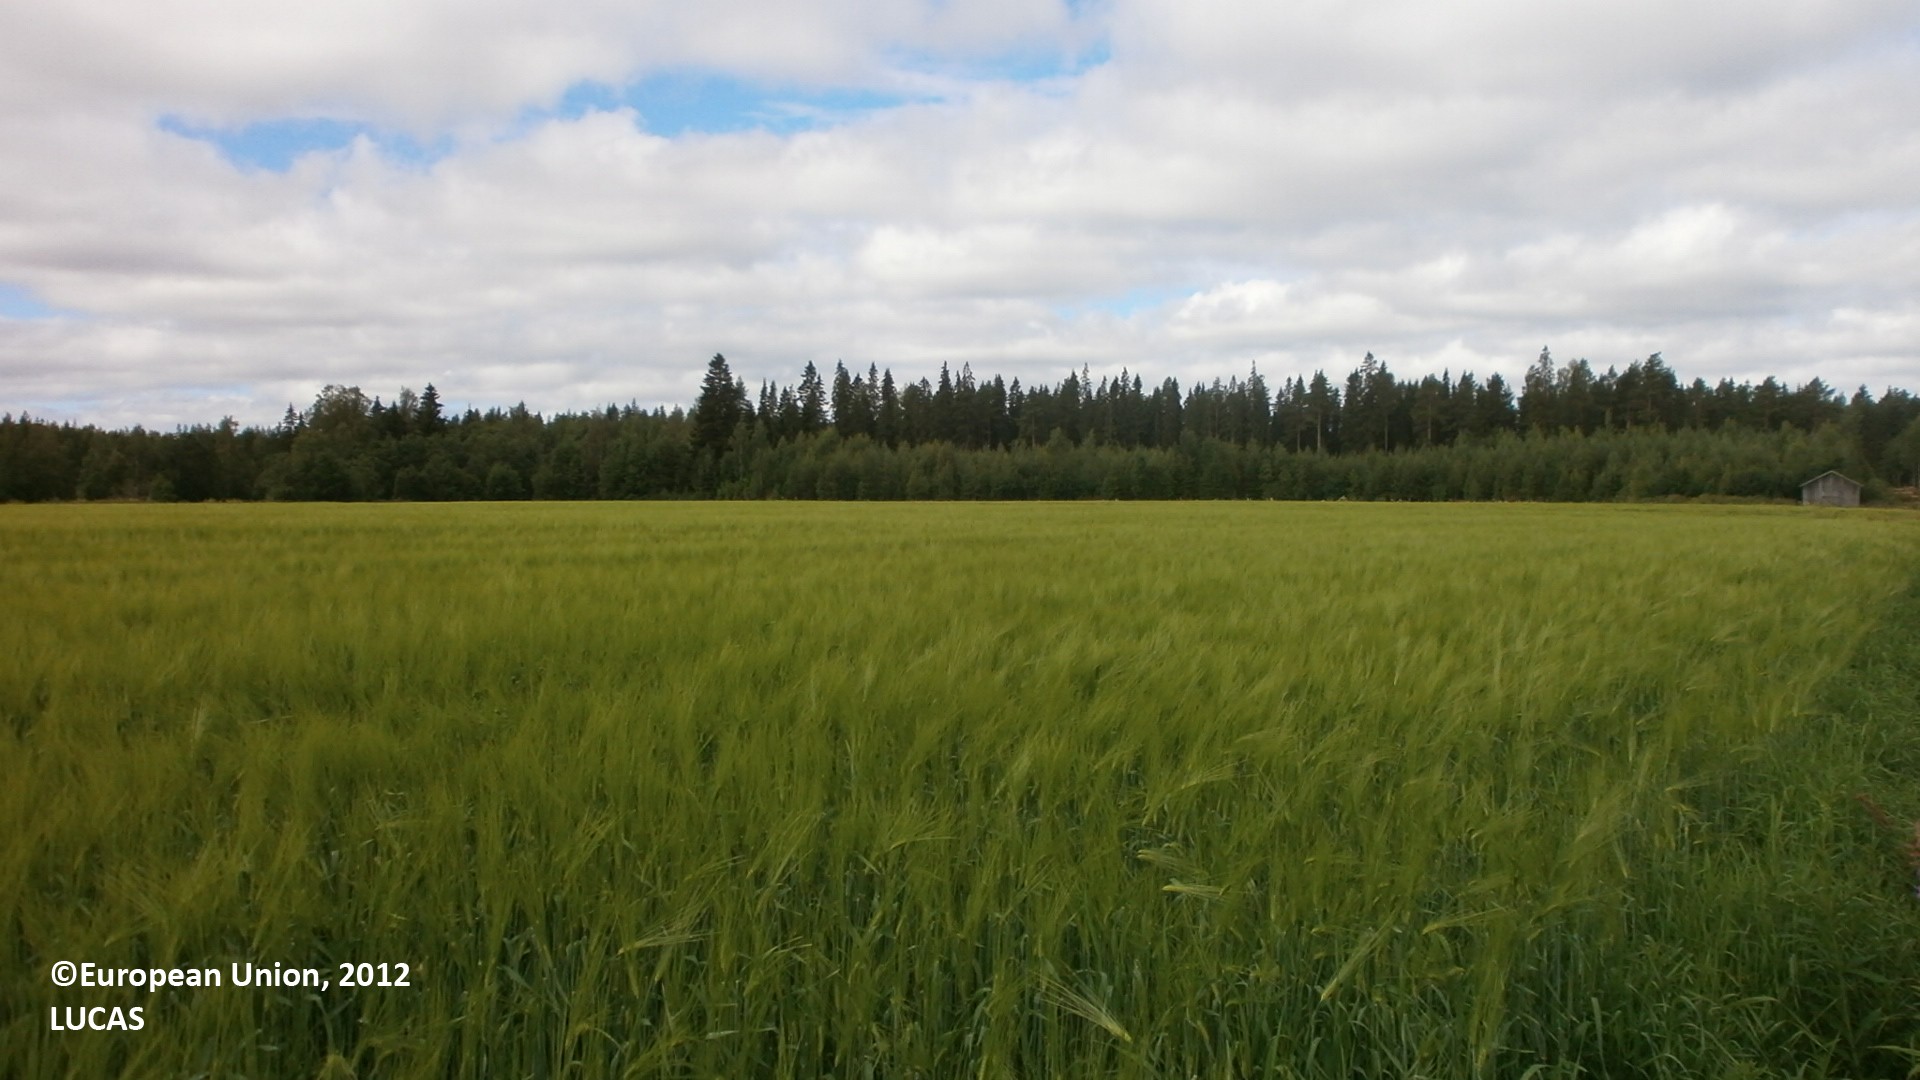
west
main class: Cropland
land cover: Barley
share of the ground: > 75 %
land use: Agriculture (excluding fallow land and kitchen gardens)
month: July
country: FI
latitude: 63.9993
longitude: 23.7388
